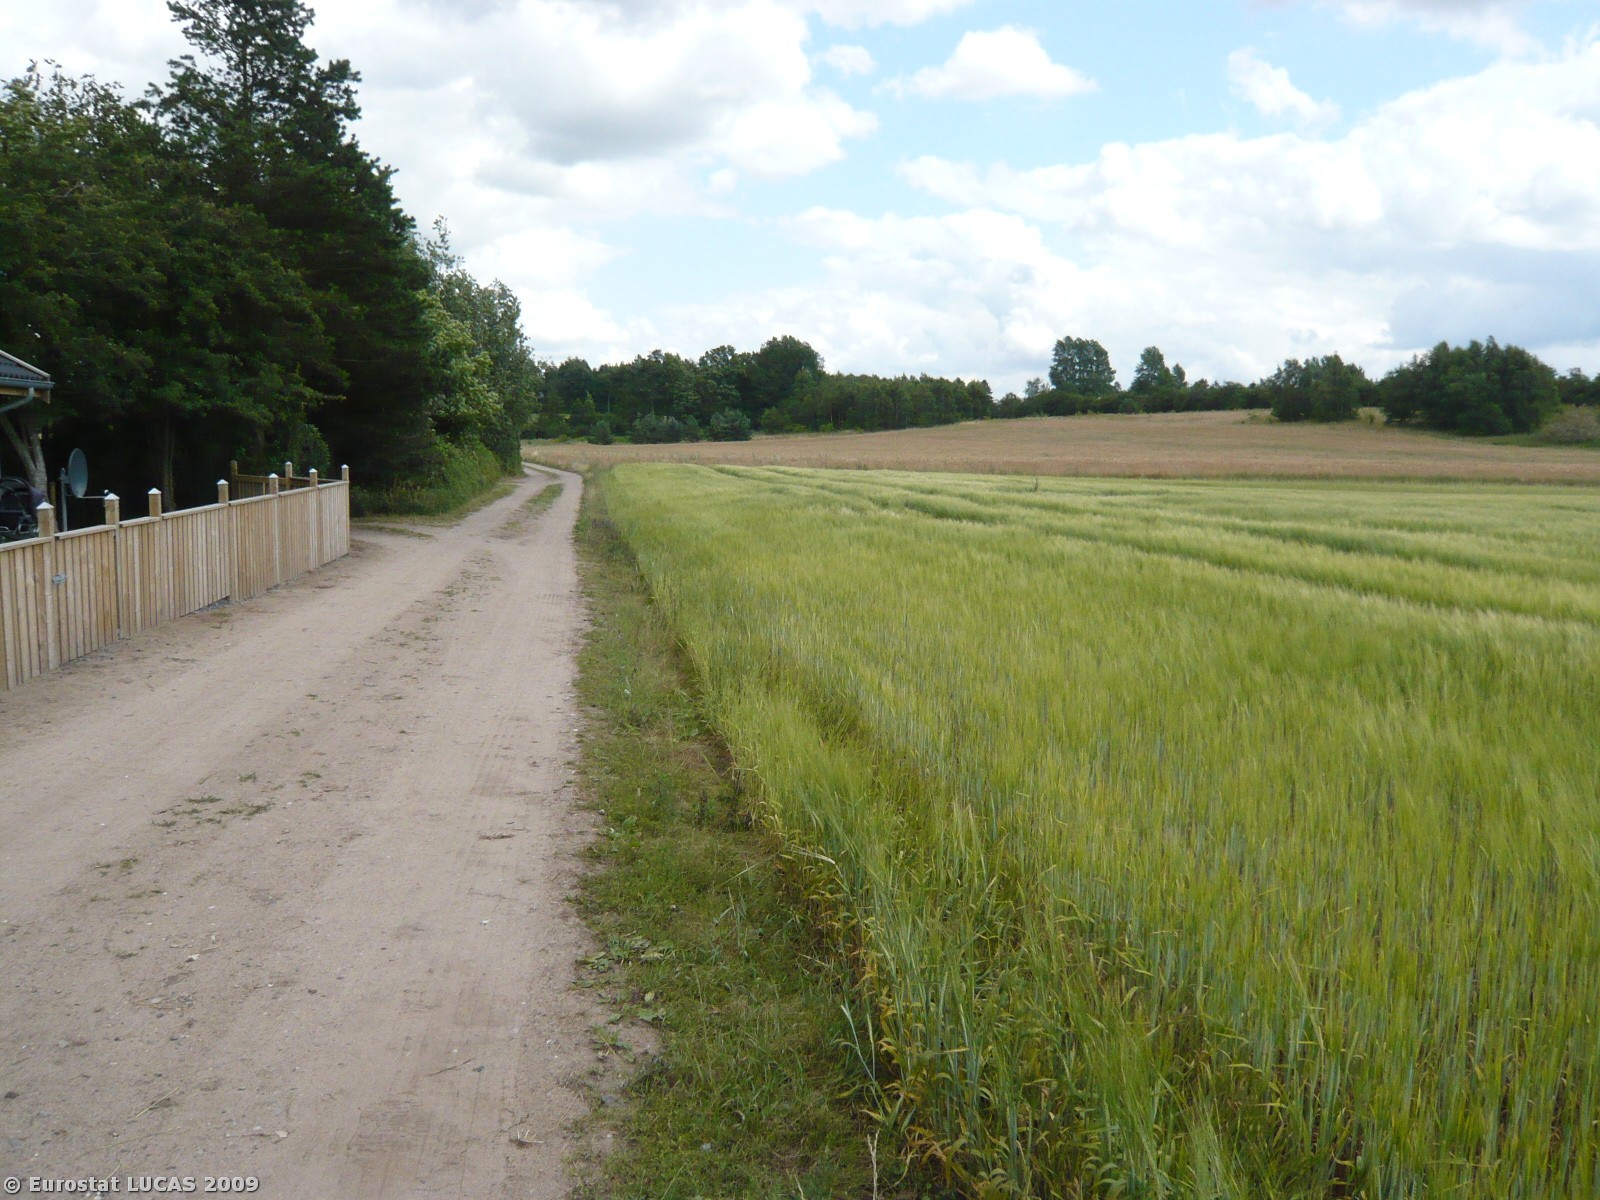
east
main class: Cropland
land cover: Barley
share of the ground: > 75 %
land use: Agriculture (excluding fallow land and kitchen gardens)
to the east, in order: Barley; Rye; Spontaneously vegetated surfaces; Grassland with sparse tree/shrub cover
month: July
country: DK
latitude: 55.5677
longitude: 11.5051
